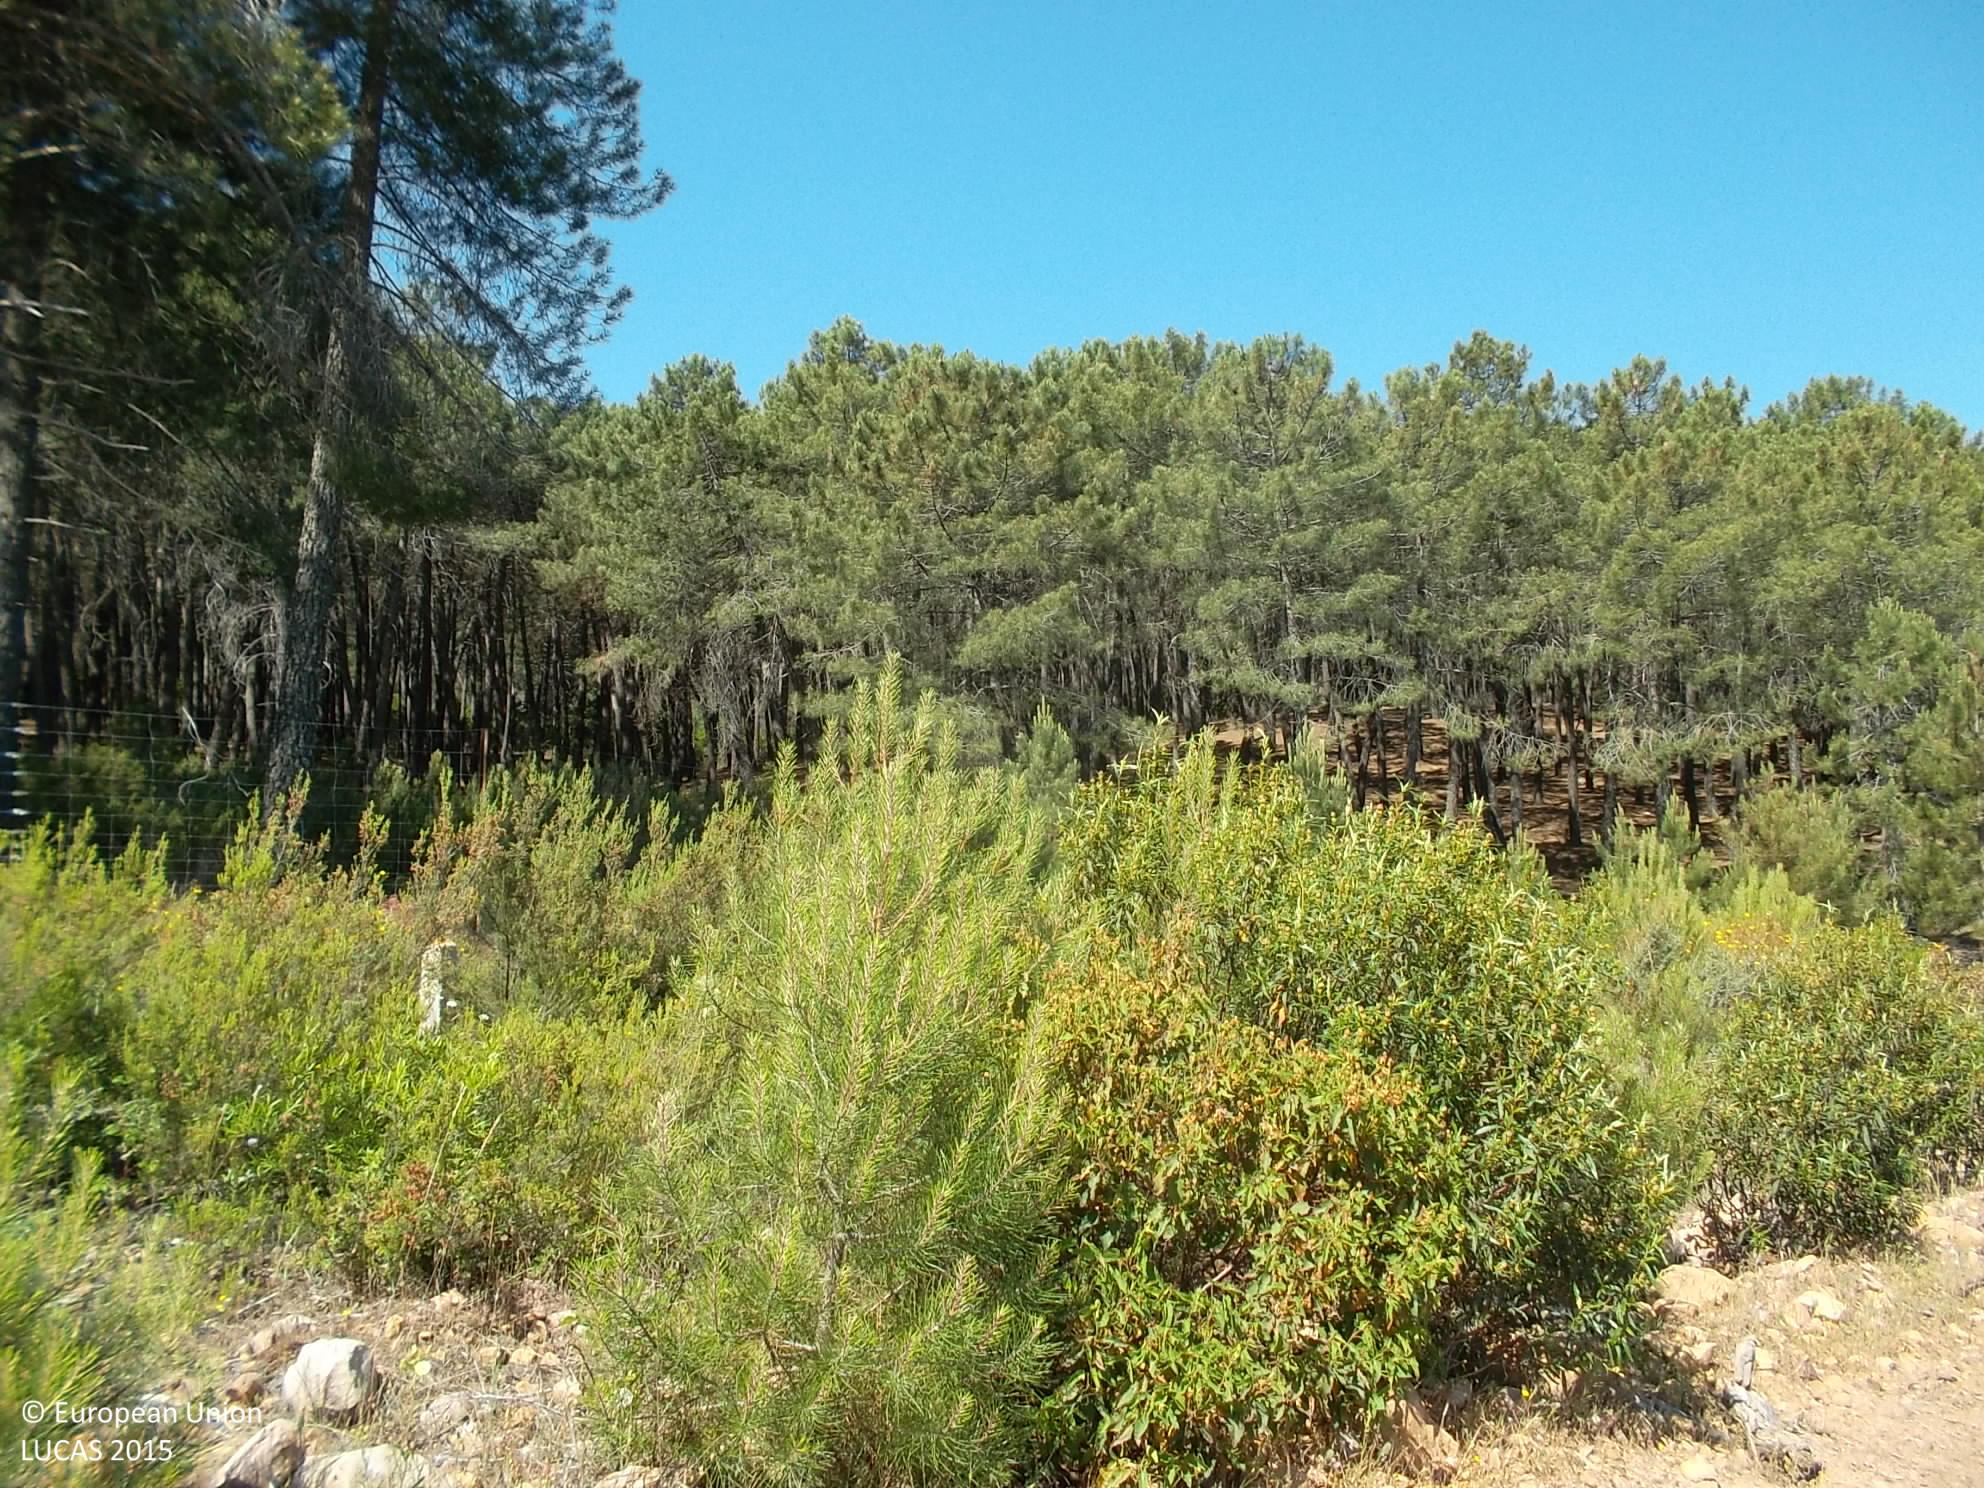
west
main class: Grassland
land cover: Grassland without tree/shrub cover
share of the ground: 50 - 75 %
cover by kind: herbaceous plants 75 %, unconsolidated bare surface 20 %, shrubs 5 %
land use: Protection infrastructures
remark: Fire break
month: May
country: ES
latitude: 38.4711
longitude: -4.3569
